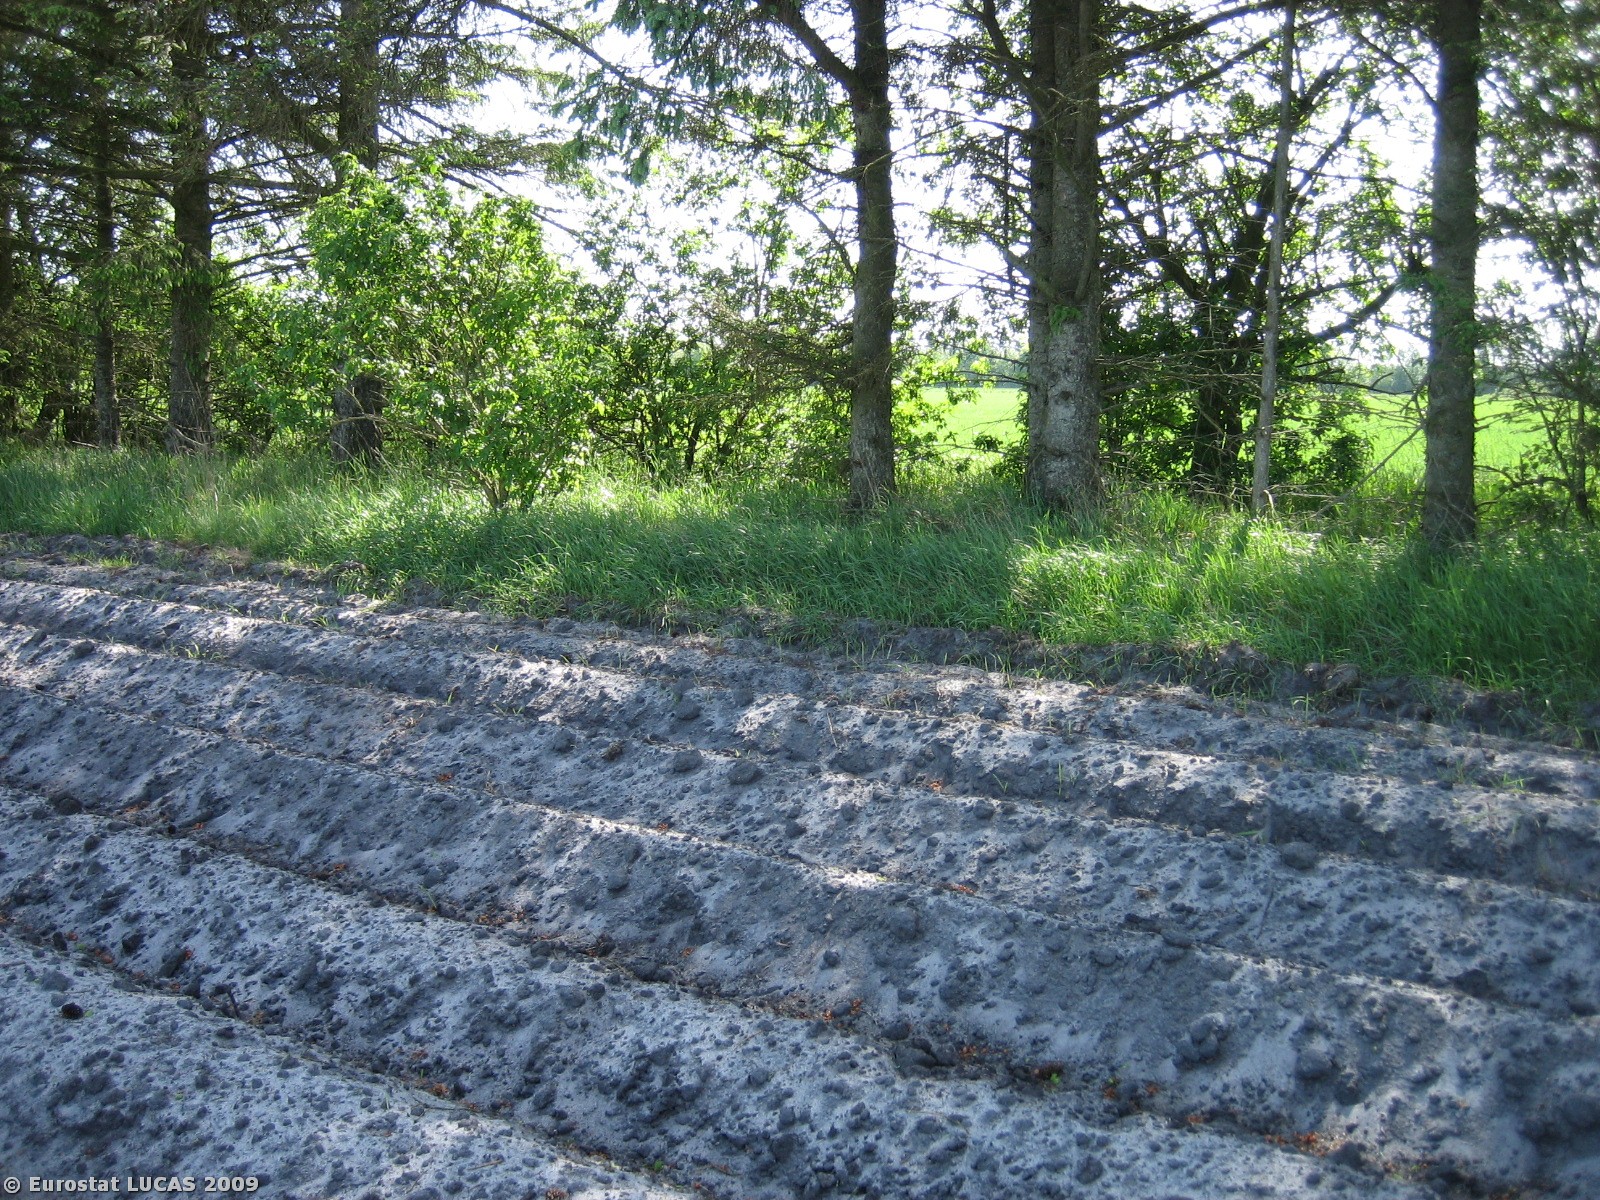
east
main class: Cropland
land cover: Potatoes
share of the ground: < 10 %
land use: Agriculture (excluding fallow land and kitchen gardens)
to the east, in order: Potatoes; Coniferous woodland; Ditches and canals; Rye; Grass margins; Ditches and canals; Grass margins; Rye
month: May
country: DK
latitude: 56.1851
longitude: 9.1793
